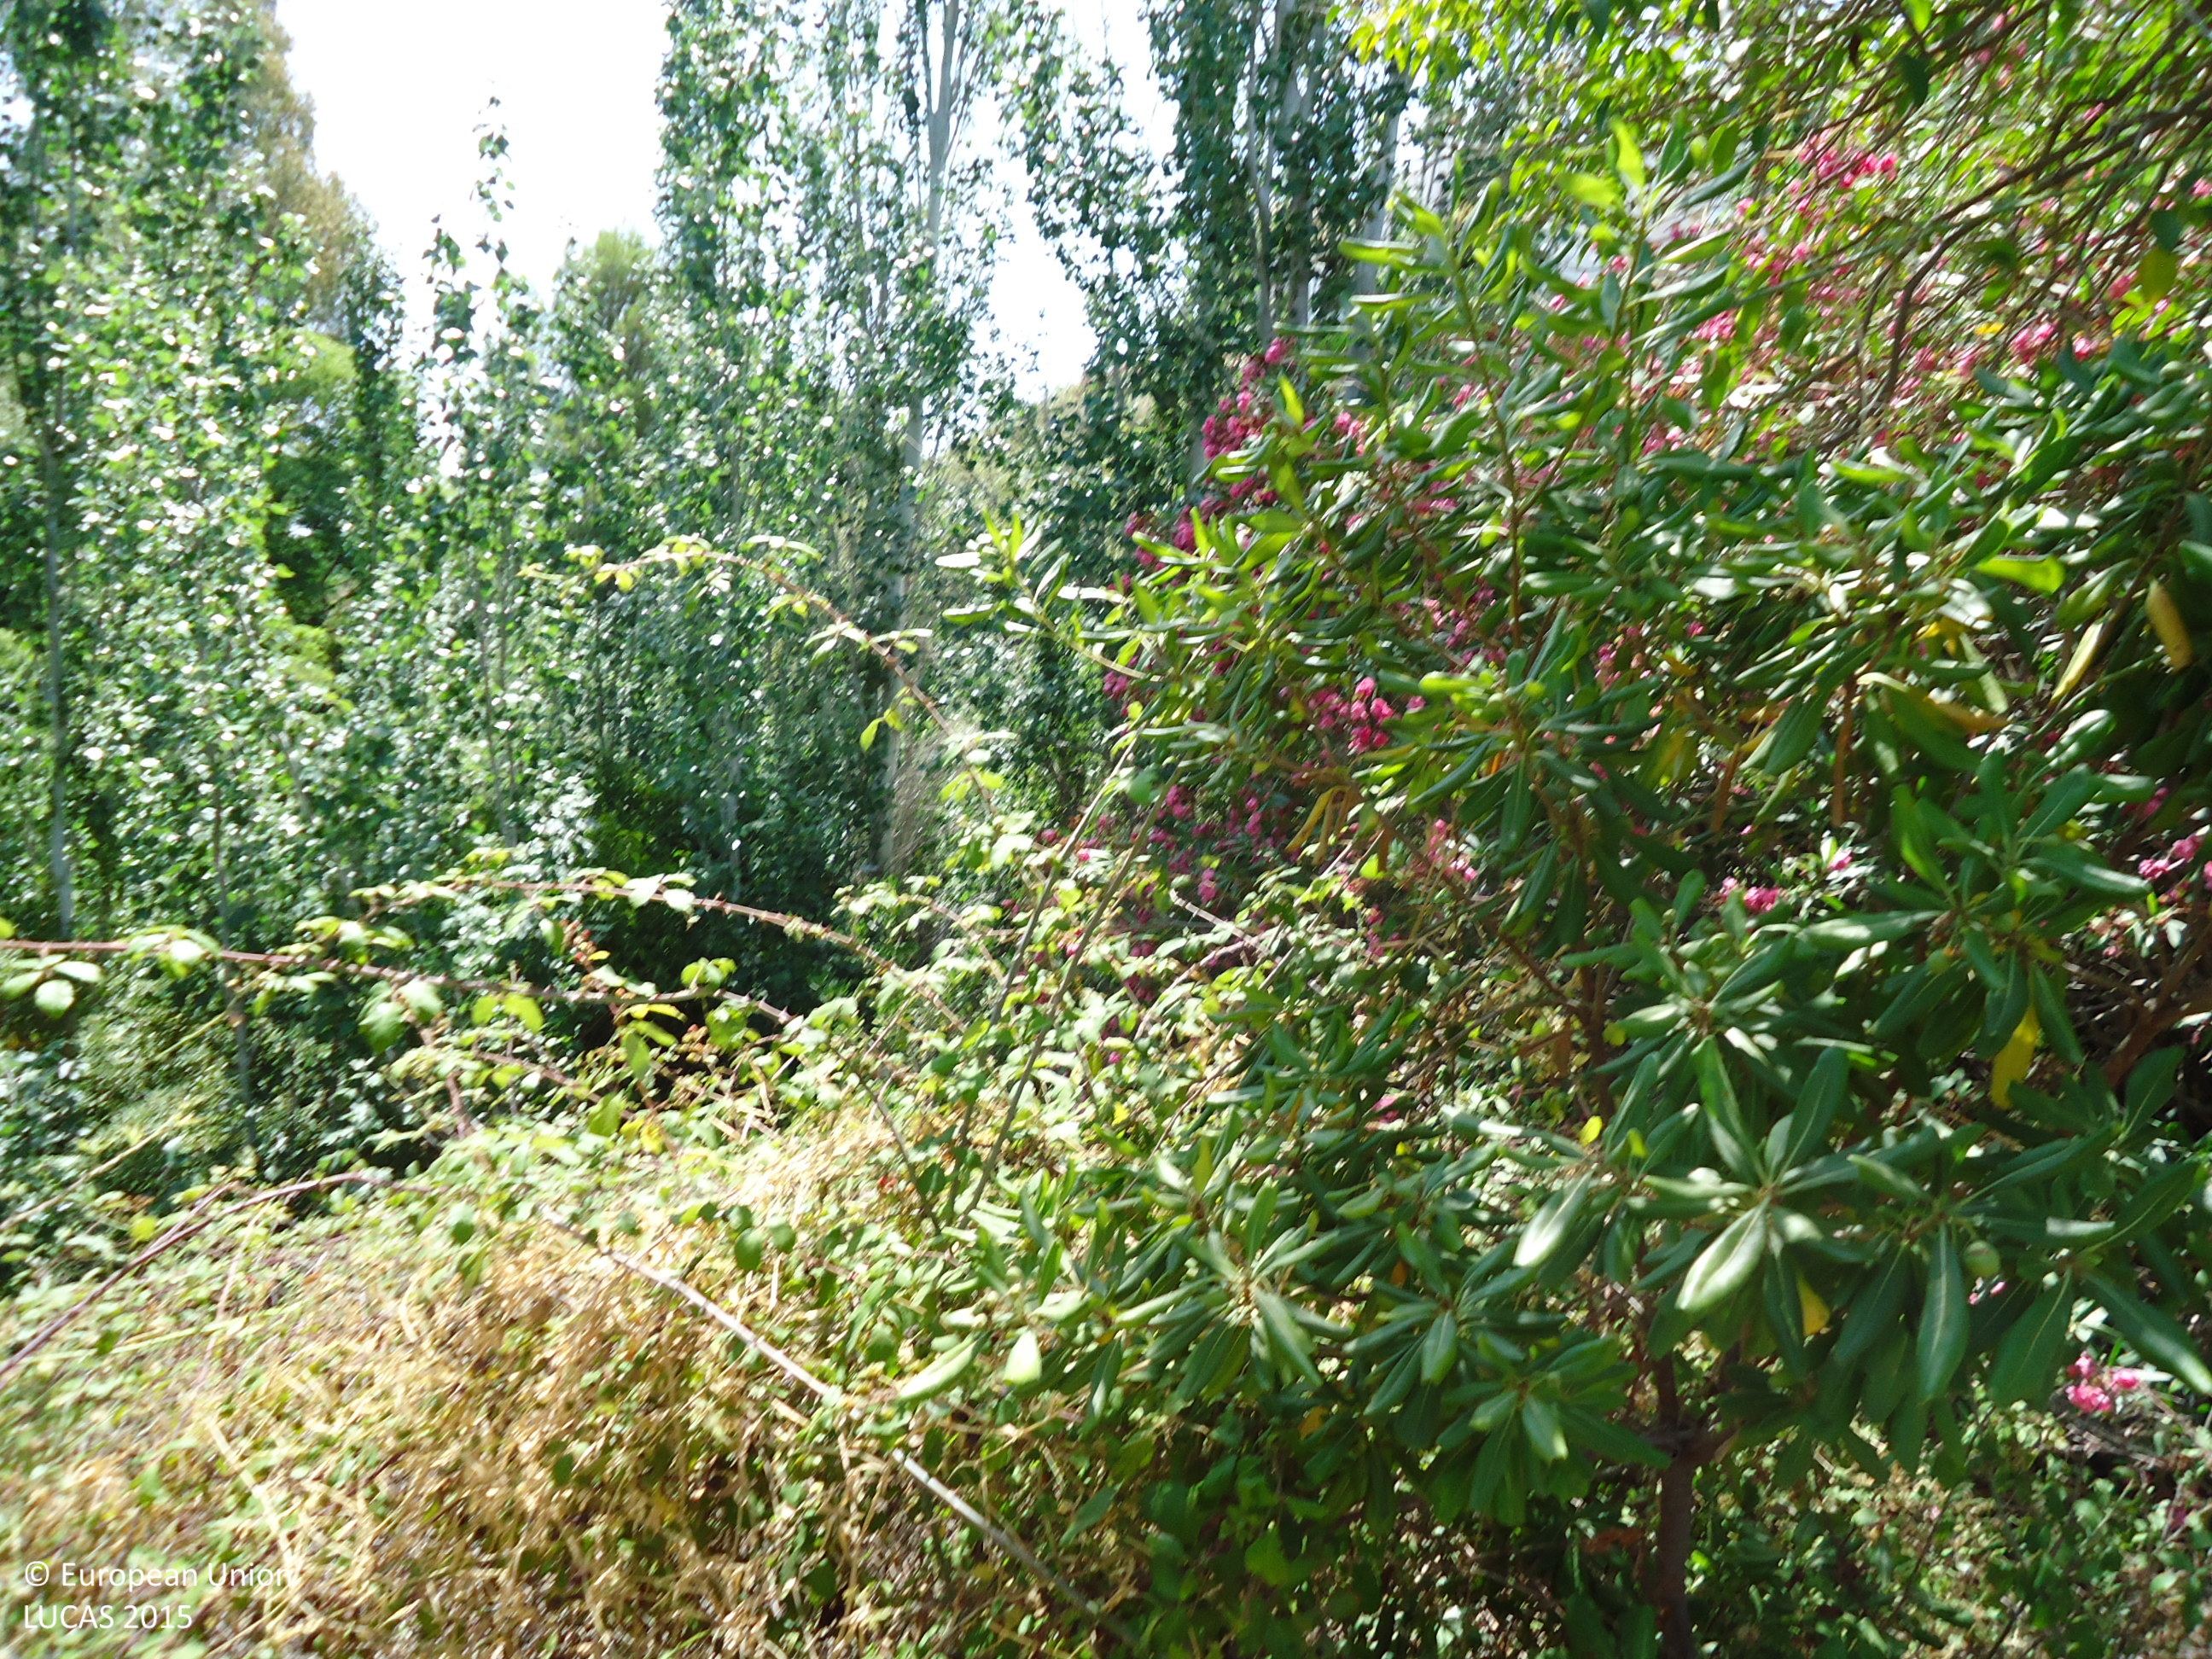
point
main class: Woodland
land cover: Broadleaved woodland
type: non-riverine alder, birch or aspen forest
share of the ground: > 75 %
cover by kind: broadleaved forest trees 95 %, shrubs 5 %
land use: Sport
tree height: > 5 m
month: July
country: ES
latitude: 36.5395
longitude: -4.7232
